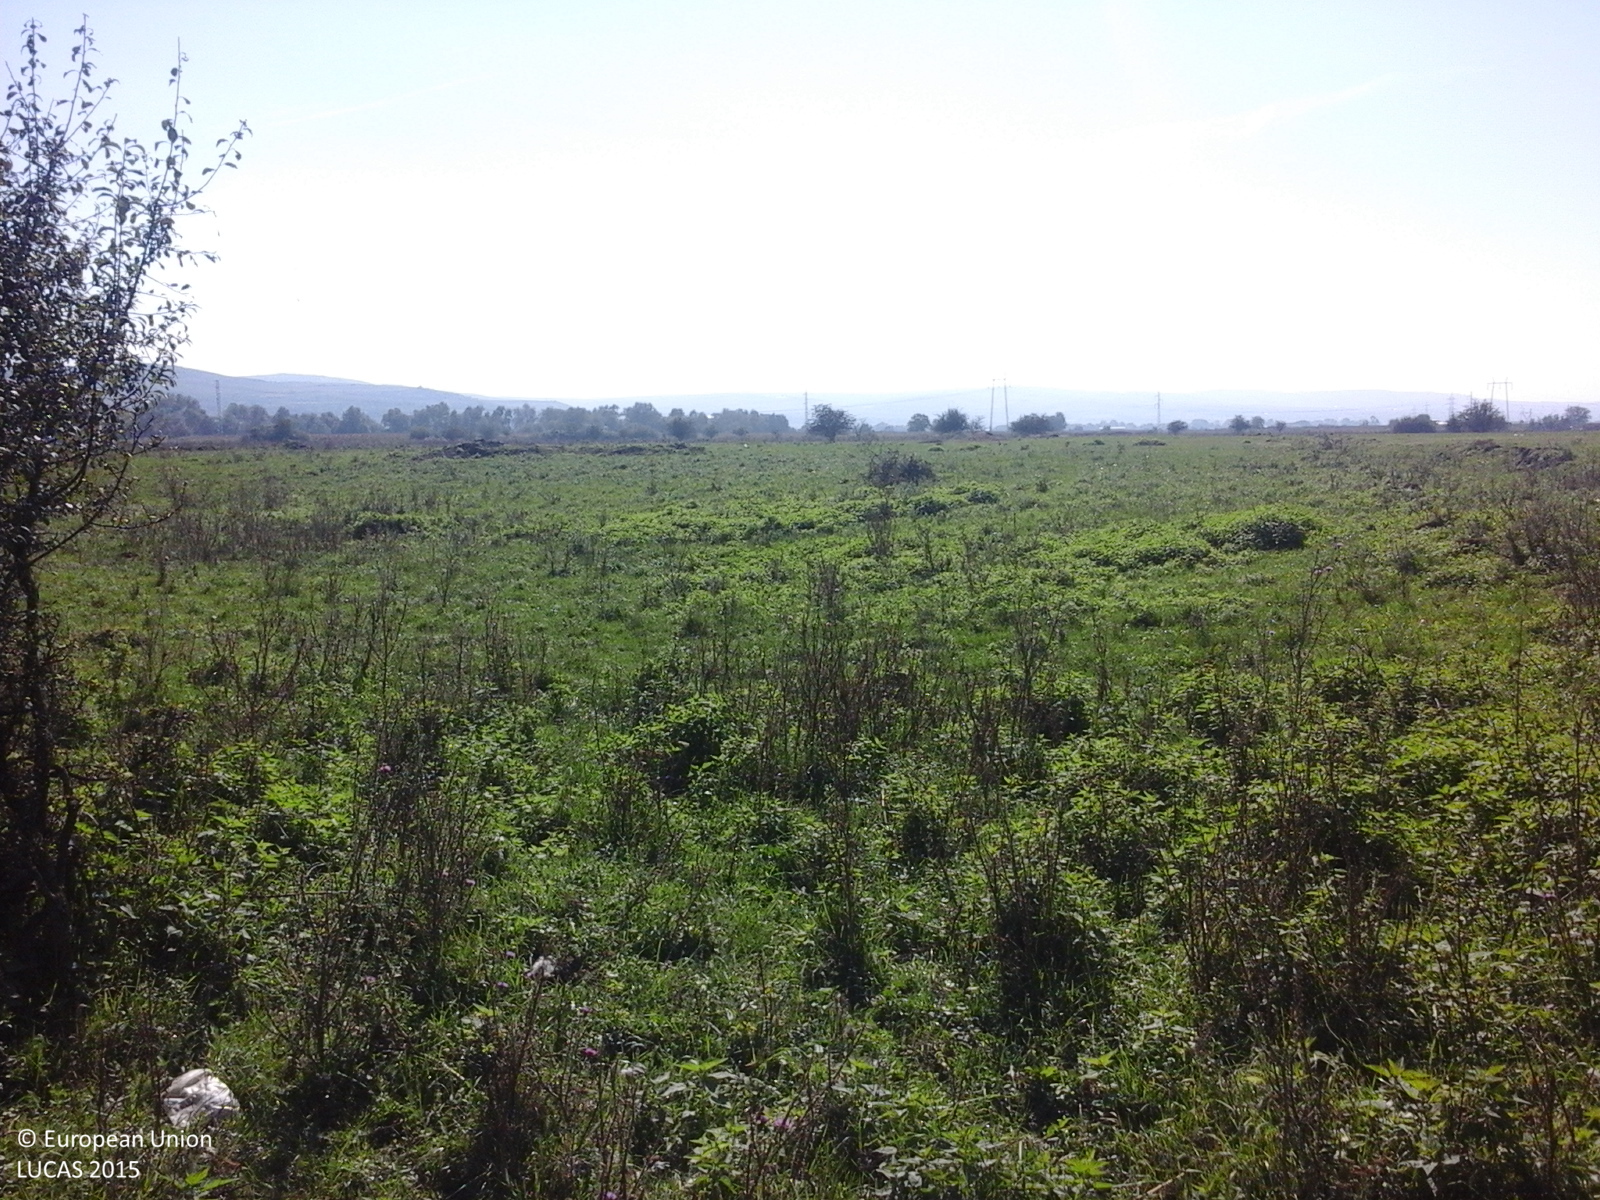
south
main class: Grassland
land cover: Spontaneously vegetated surfaces
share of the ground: > 75 %
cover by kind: herbaceous plants 100 %
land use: Agriculture (excluding fallow land and kitchen gardens)
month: October
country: RO
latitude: 46.0971
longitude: 23.6101
